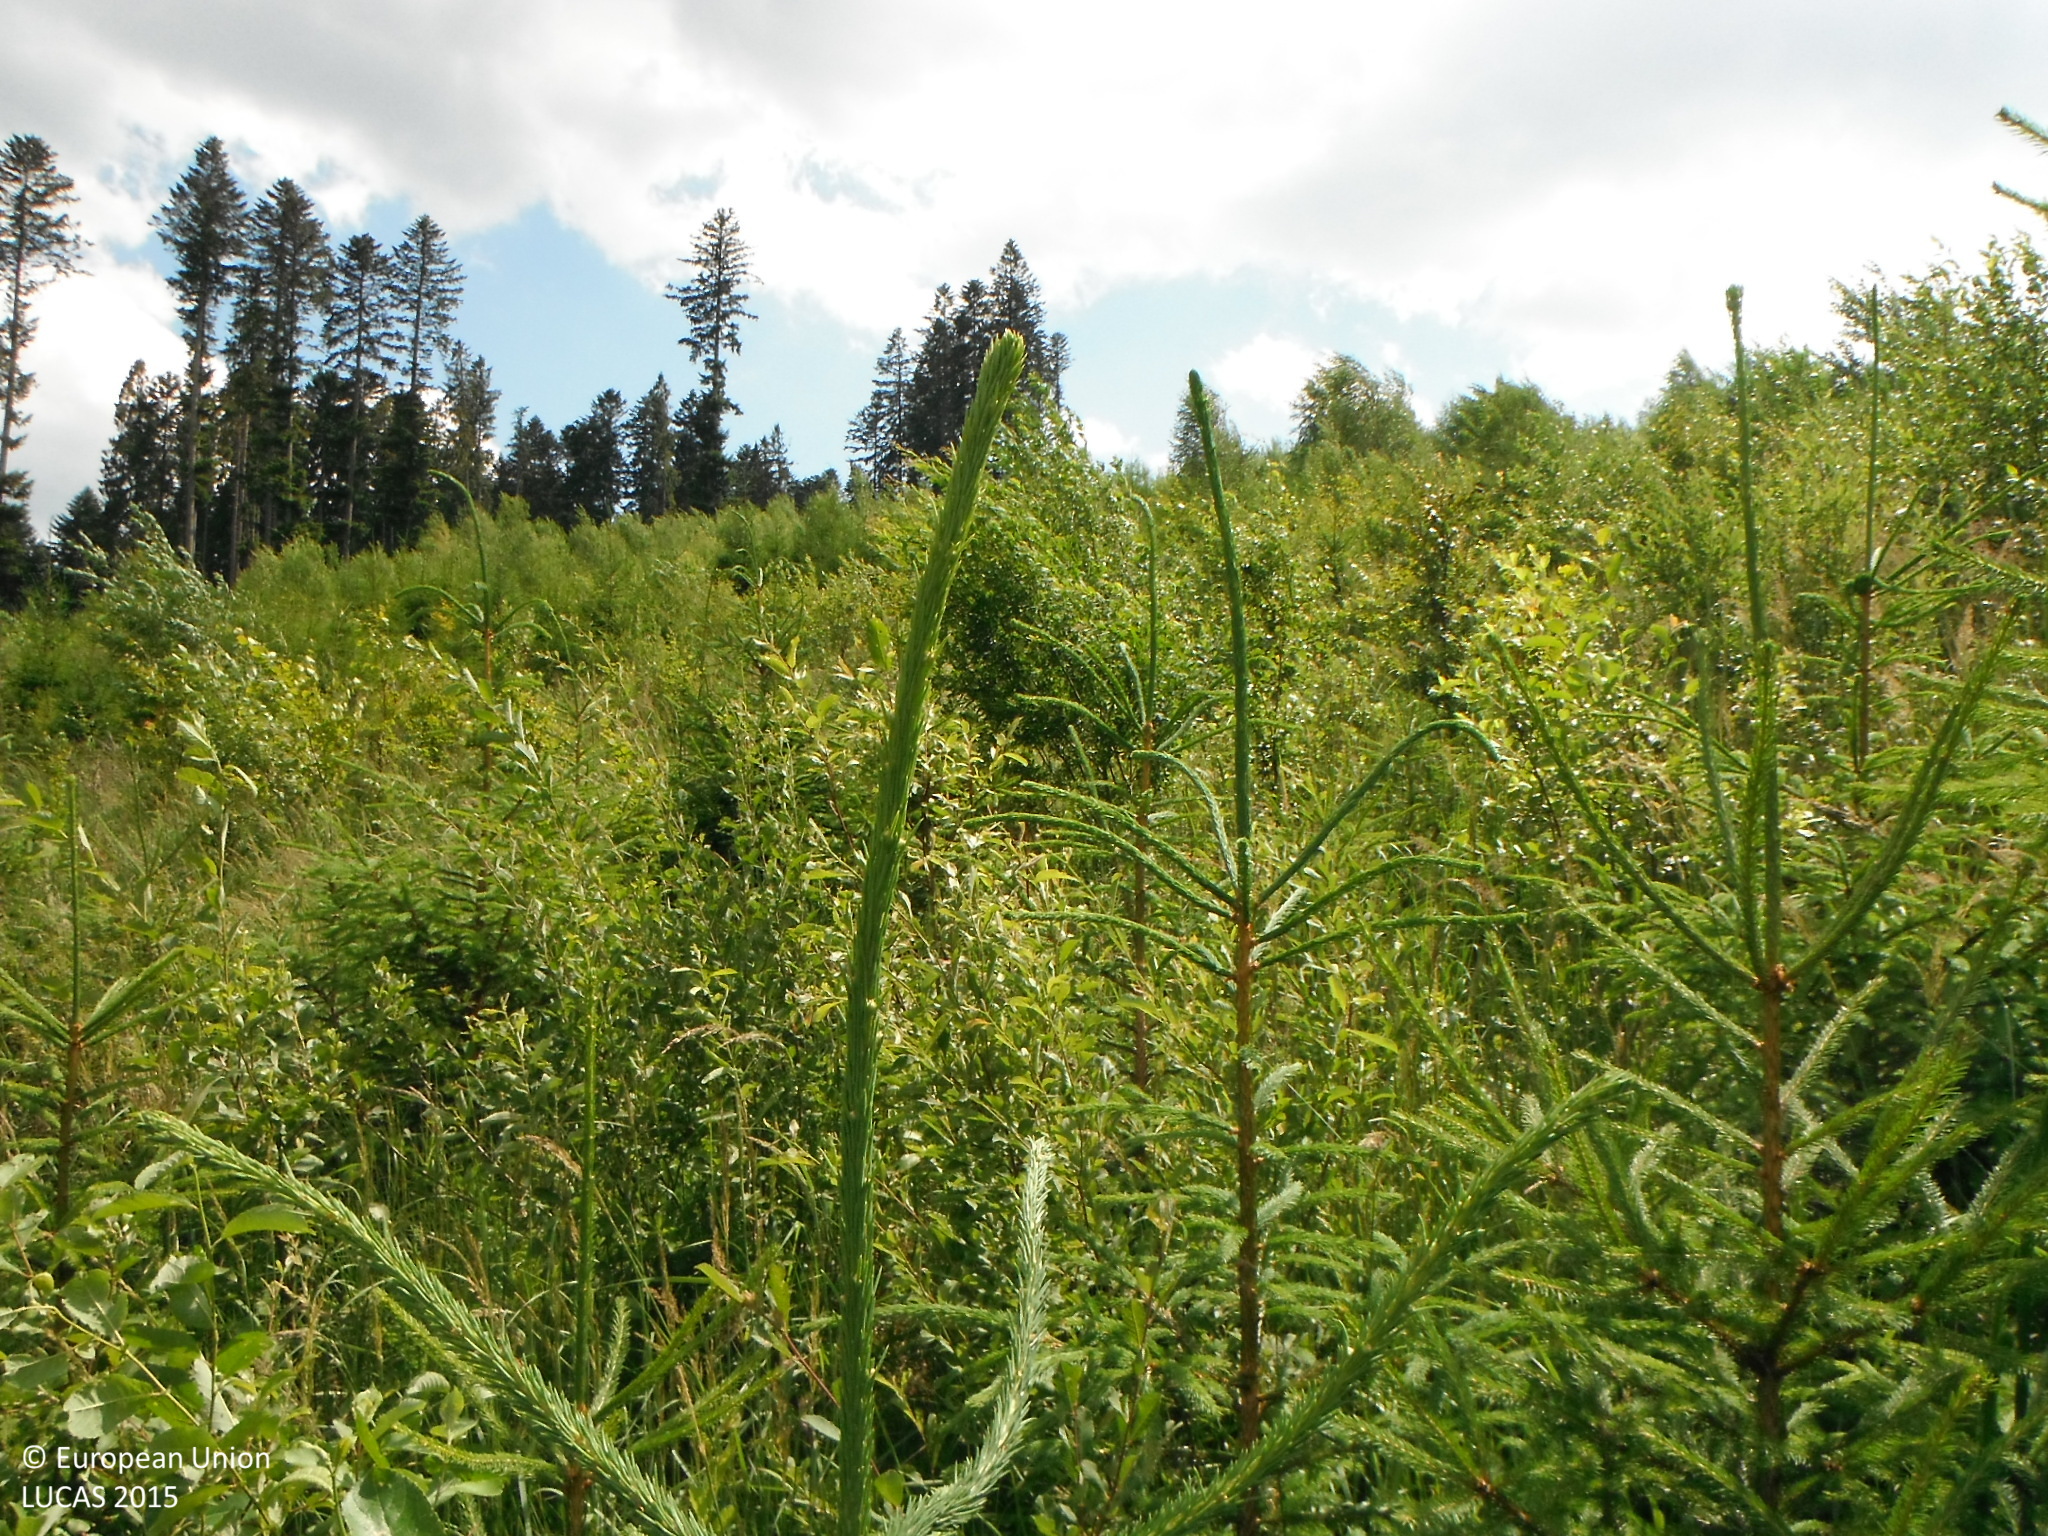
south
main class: Shrubland
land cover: Shrubland without tree cover
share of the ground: > 75 %
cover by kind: shrubs 80 %, herbaceous plants 20 %
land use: Forestry
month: July
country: SK
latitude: 49.3868
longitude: 19.5185
